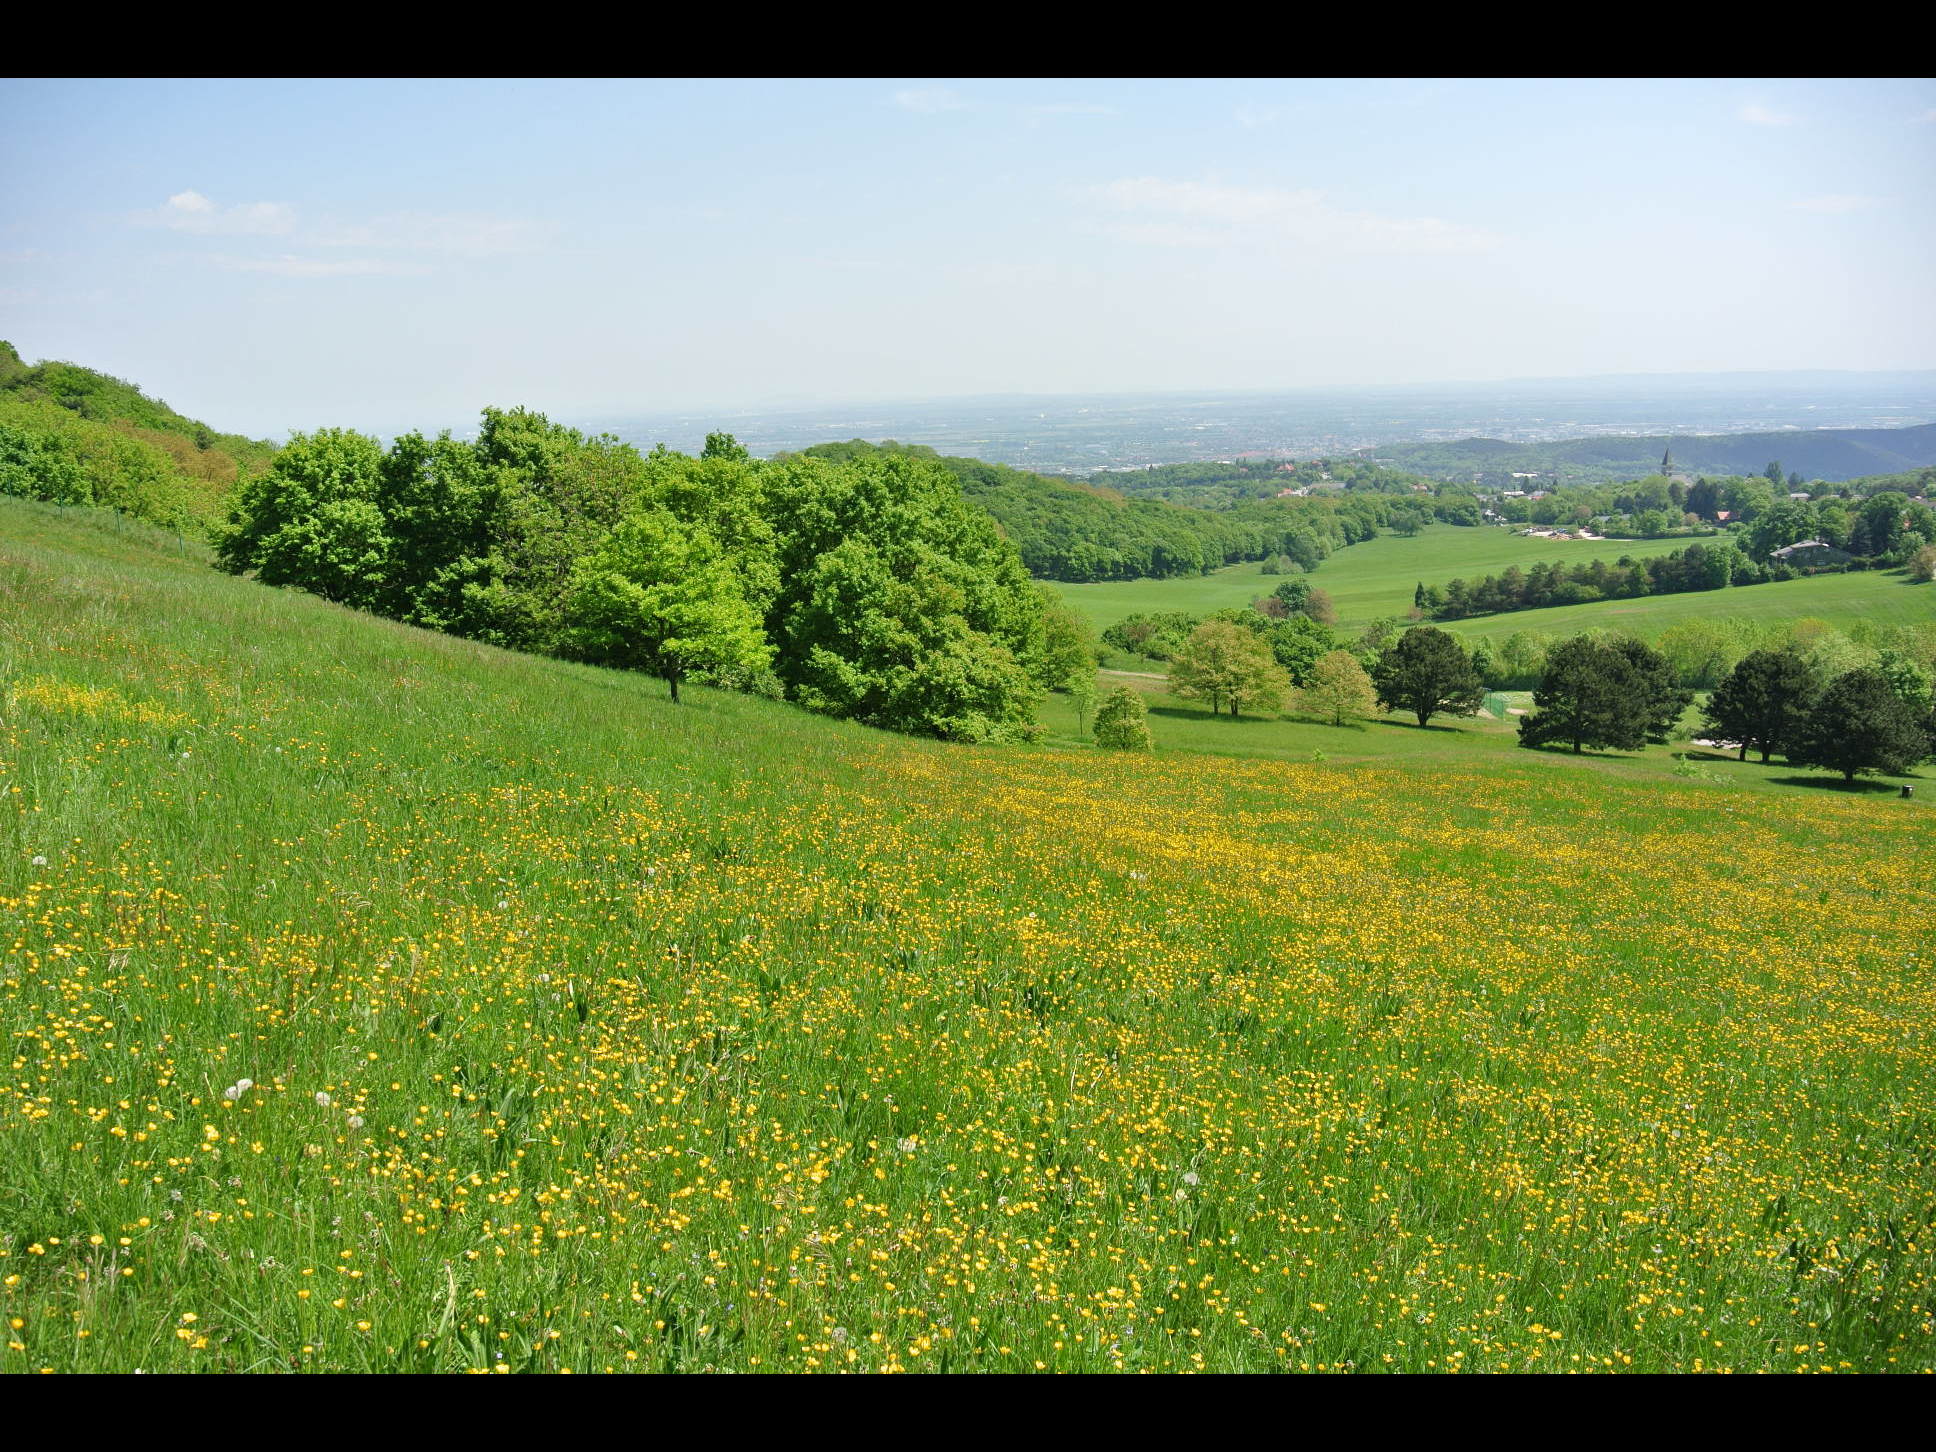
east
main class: Grassland
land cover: Grassland without tree/shrub cover
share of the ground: > 75 %
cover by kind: herbaceous plants 100 %
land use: Agriculture (excluding fallow land and kitchen gardens)
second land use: Amenities, museums, leisure
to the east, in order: Grassland without tree/shrub cover; Single bushes/trees; Grassland without tree/shrub cover; Broadleaved woodland; Grass margins; Paved roads, cycling and walking lanes; Grassland without tree/shrub cover; Tracks; Grassland without tree/shrub cover; Broadleaved woodland; Grassland without tree/shrub cover
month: May
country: AT
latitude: 48.1019
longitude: 16.2219
